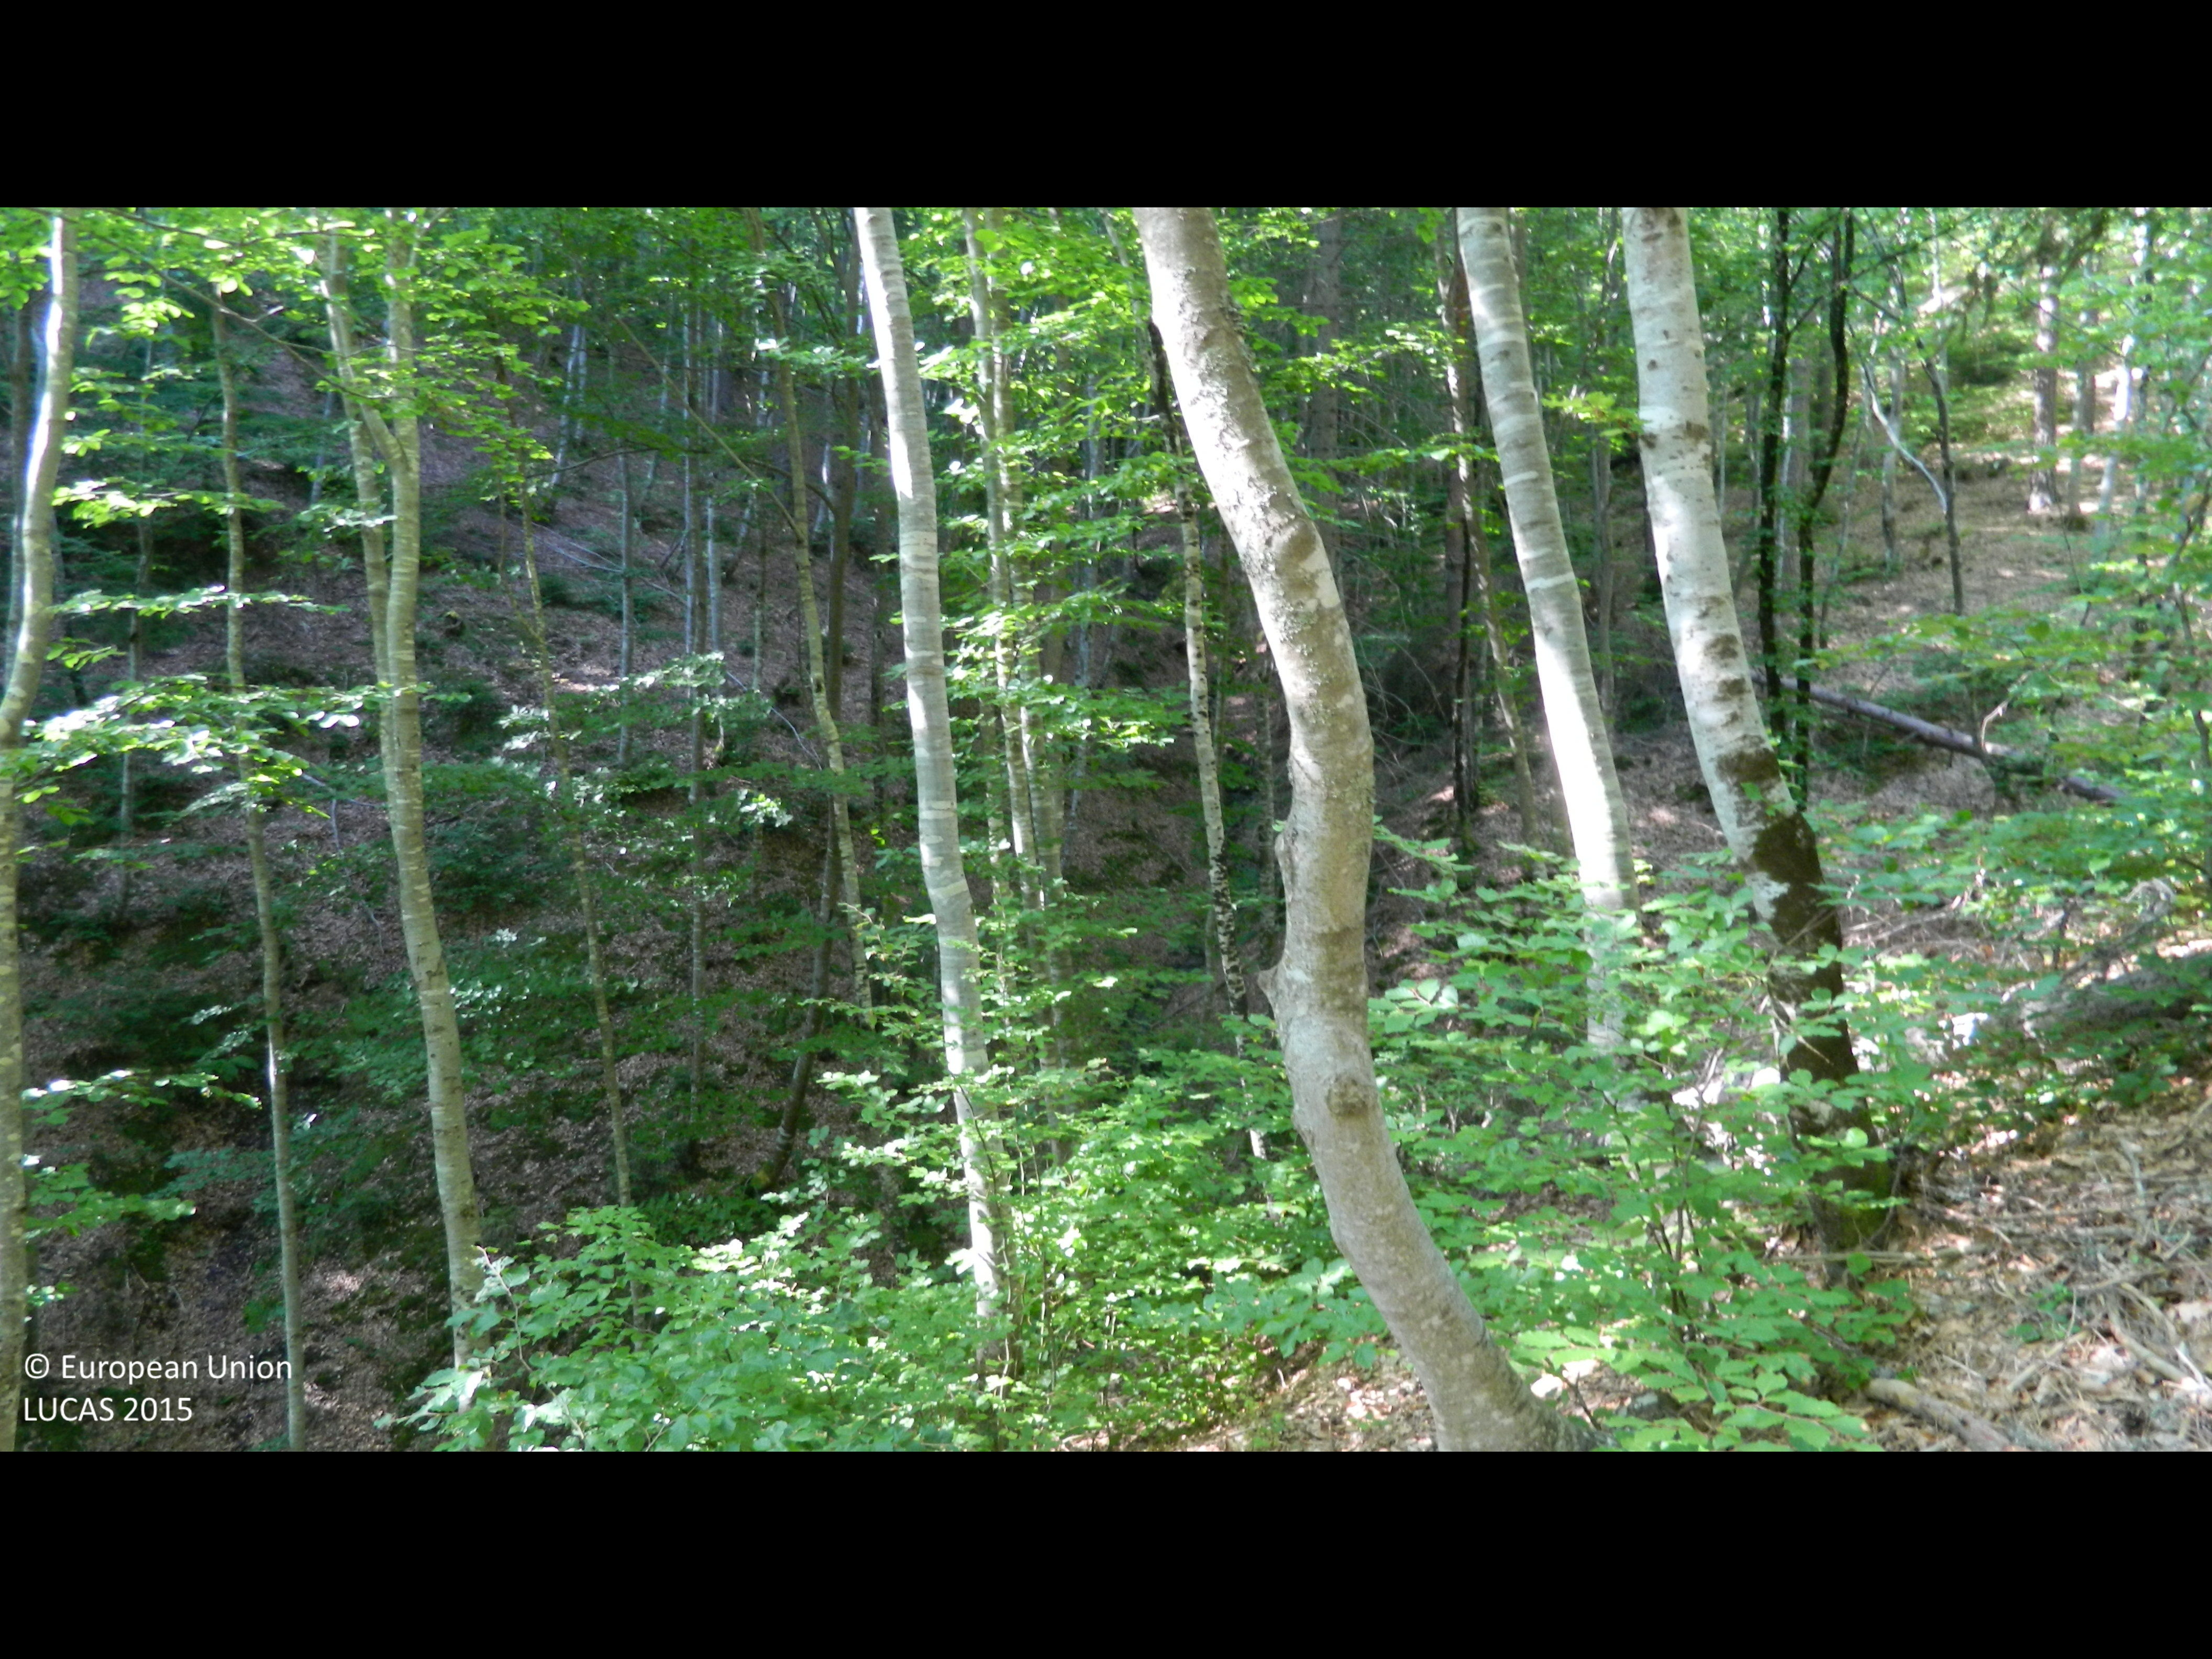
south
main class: Woodland
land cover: Broadleaved woodland
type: mountainous beech forest
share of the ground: > 75 %
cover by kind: broadleaved forest trees 85 %, coniferous forest trees 10 %, unconsolidated bare surface 5 %
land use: Forestry
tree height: > 5 m
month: July
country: BG
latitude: 41.5413
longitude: 24.8012
